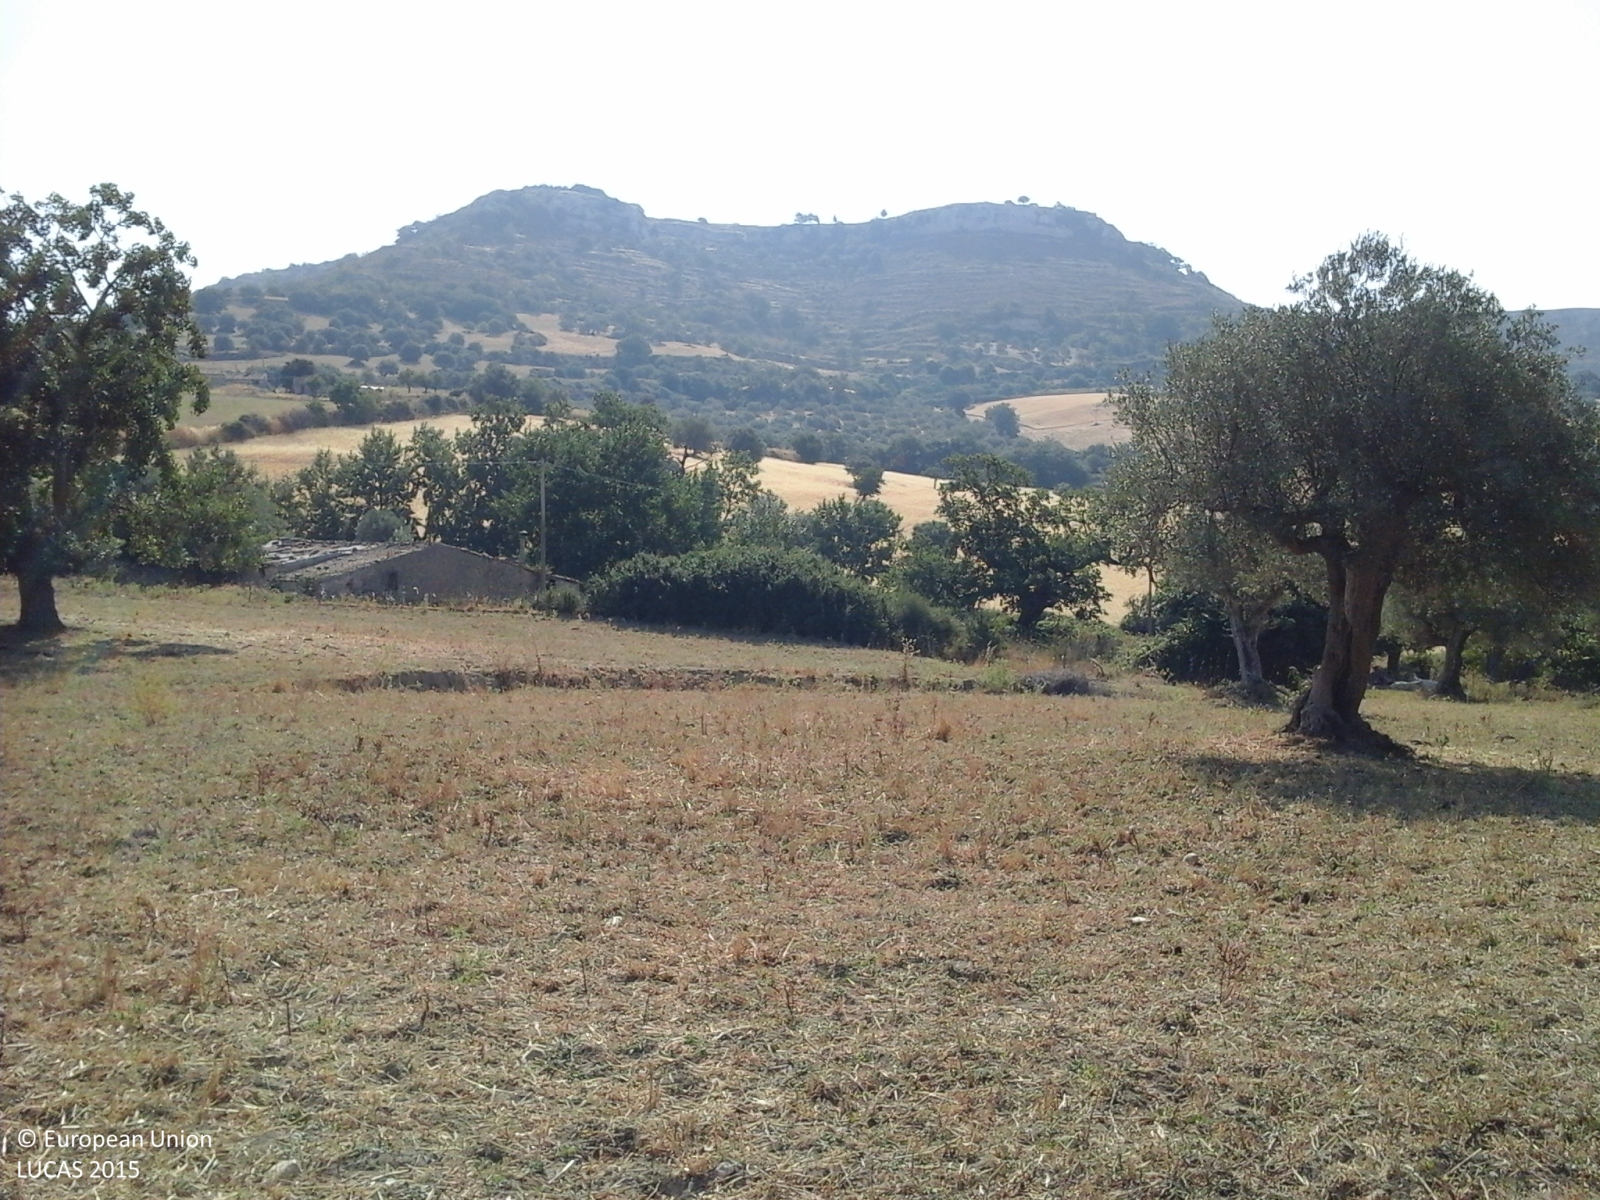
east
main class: Cropland
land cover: Mixed cereals for fodder
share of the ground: > 75 %
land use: Agriculture (excluding fallow land and kitchen gardens)
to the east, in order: Mixed cereals for fodder; Grass margins; Mixed cereals for fodder; Electric lines; Grassland with sparse tree/shrub cover; Grass margins; Artificial constructions in urban areas; Lines of trees; Grassland with sparse tree/shrub cover; Lines of trees; Ditches and canals; Fences; Mixed cereals for fodder; Olive groves; Mixed cereals for fodder
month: July
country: IT
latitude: 37.0585
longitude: 14.8766
